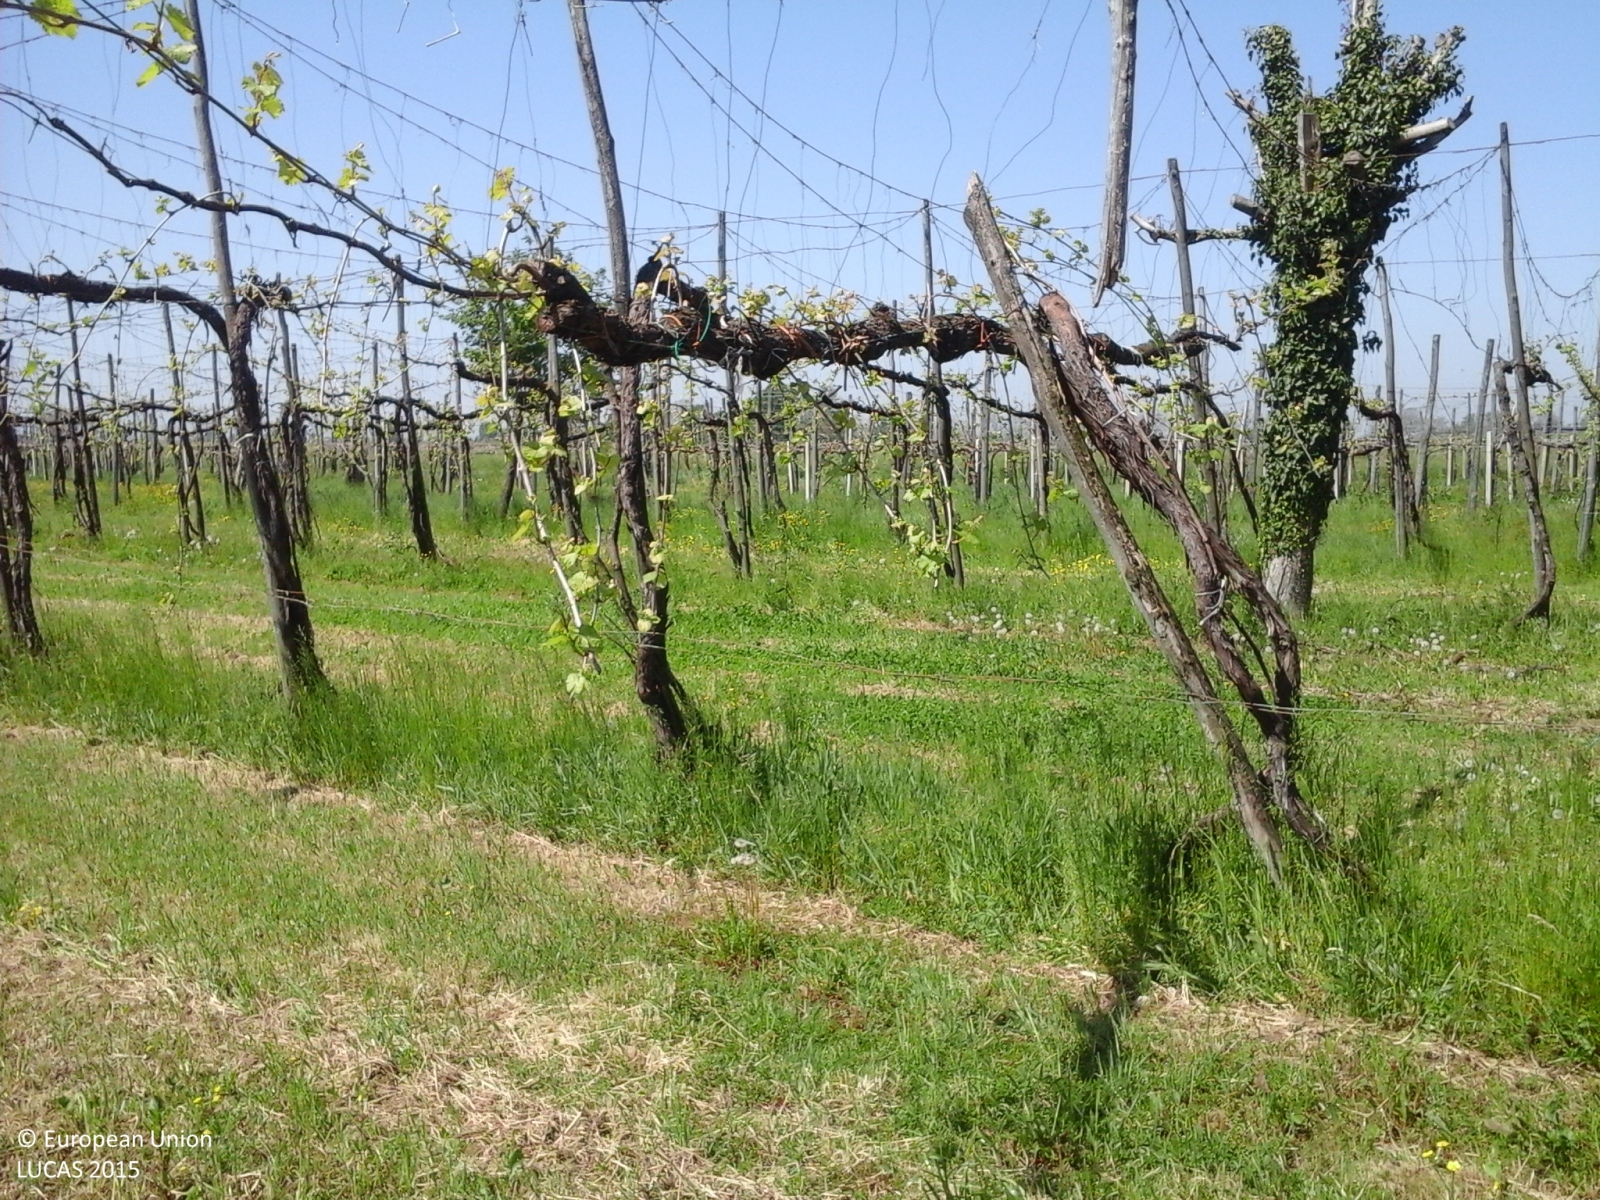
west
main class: Cropland
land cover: Vineyards
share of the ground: 10 - 25 %
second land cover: Spontaneously vegetated surfaces
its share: > 75 %
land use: Agriculture (excluding fallow land and kitchen gardens)
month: April
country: IT
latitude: 44.5812
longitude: 10.8923
